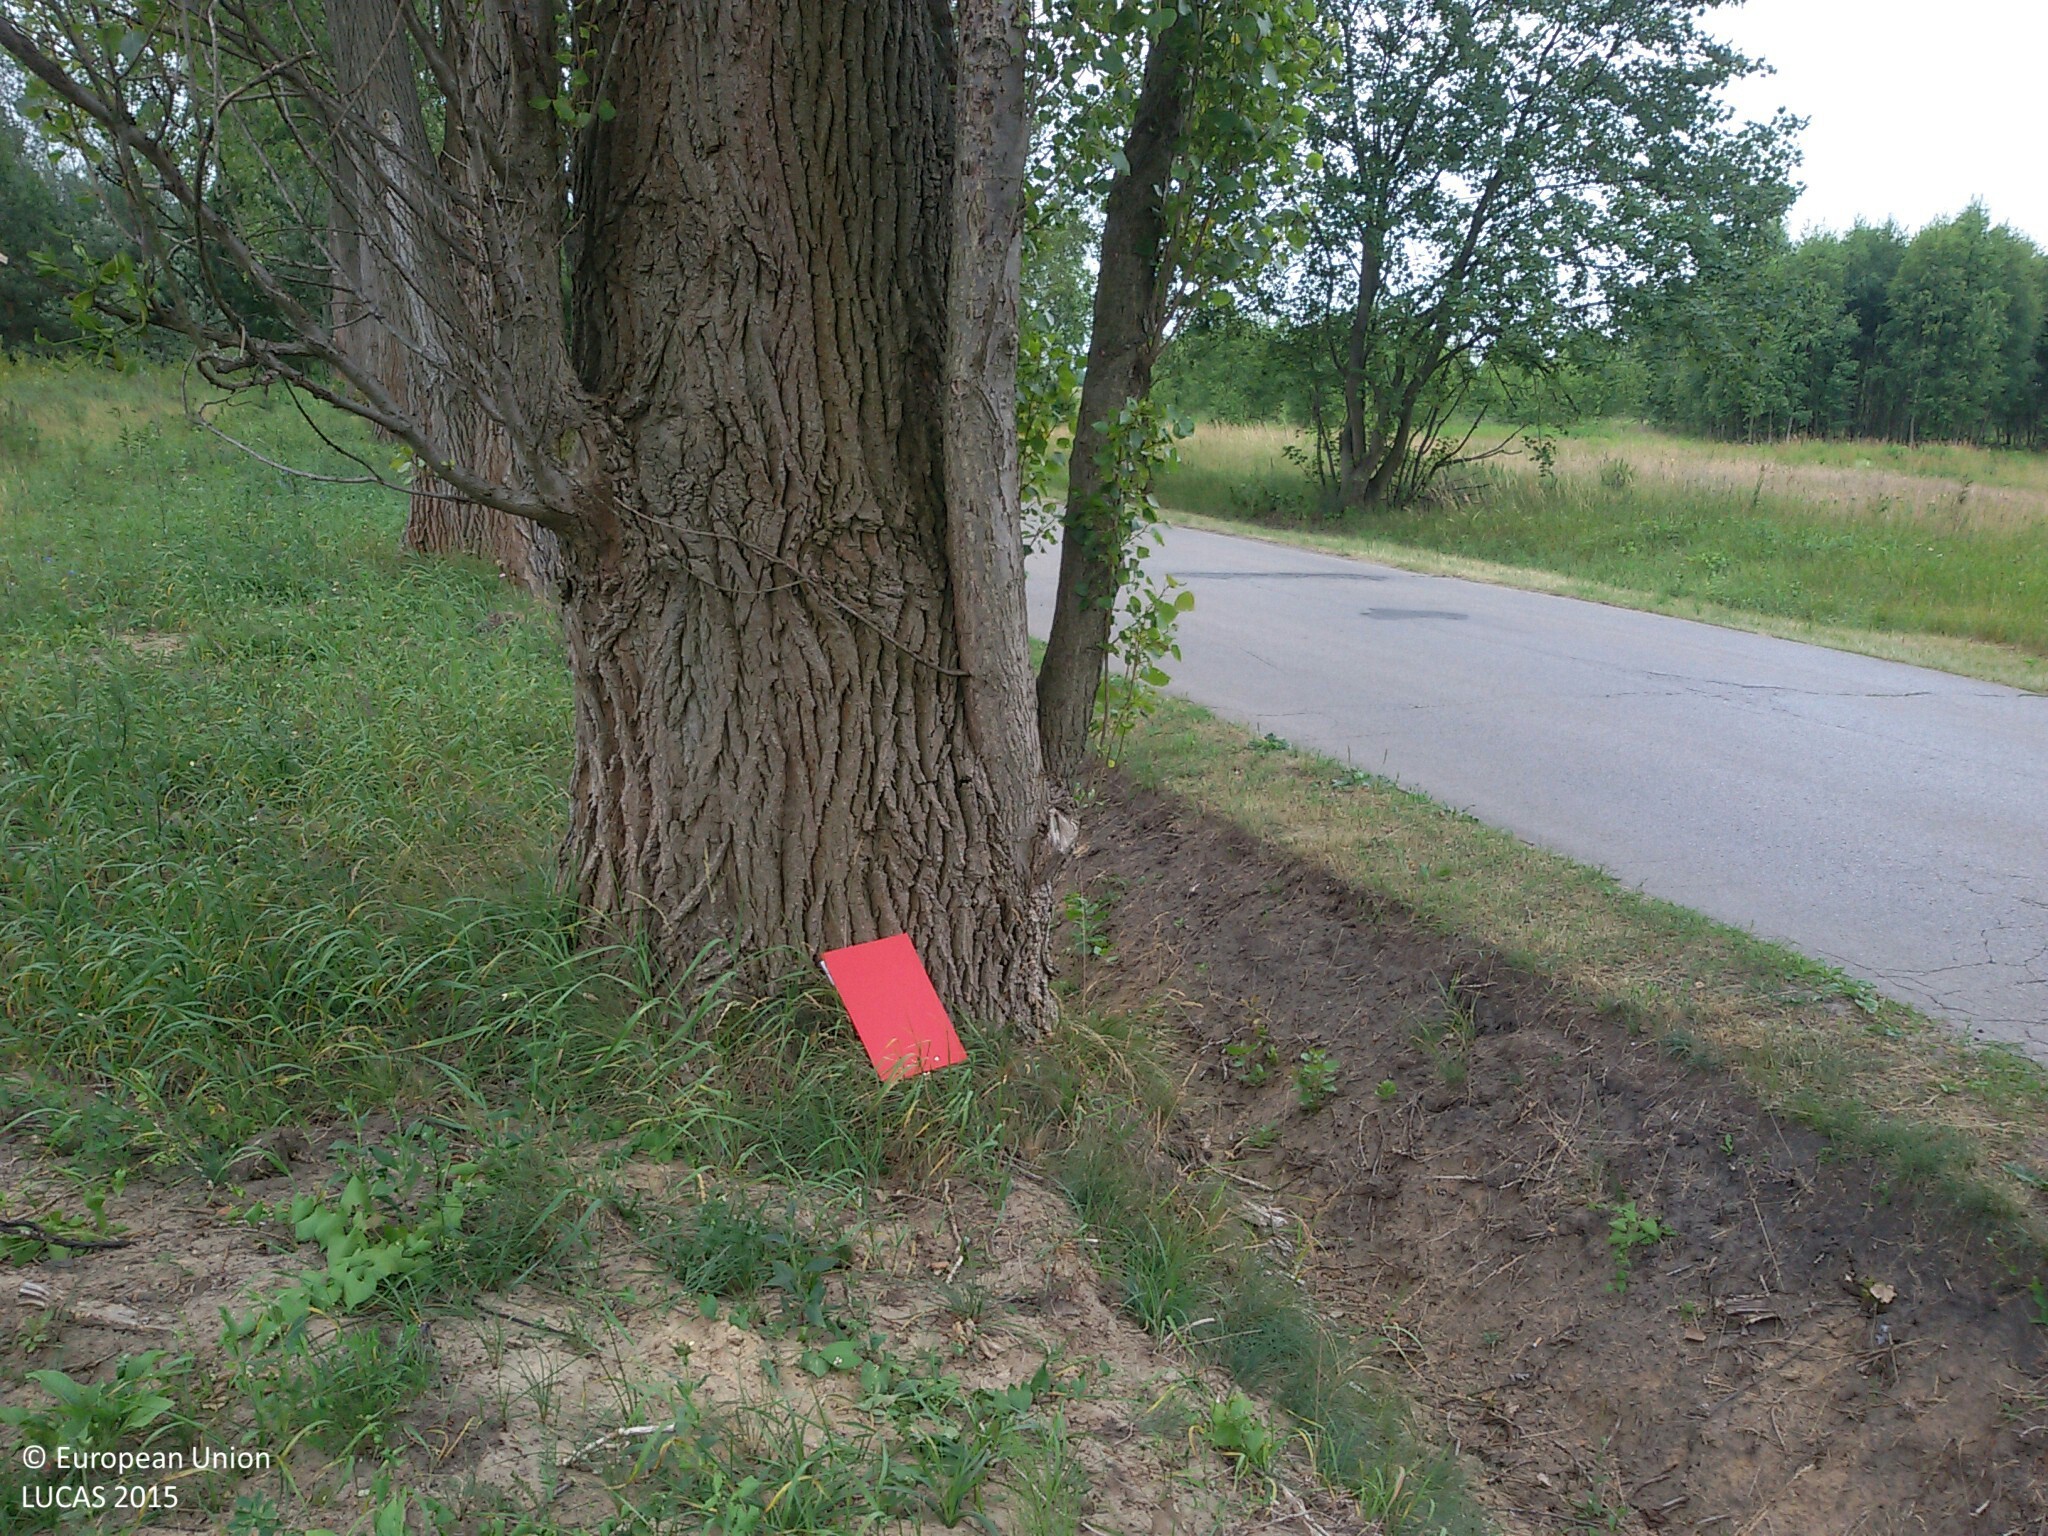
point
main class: Grassland
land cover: Grassland with sparse tree/shrub cover
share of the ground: > 75 %
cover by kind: herbaceous plants 95 %, broadleaved forest trees 5 %
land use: Road transport
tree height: > 5 m
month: June
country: PL
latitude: 52.2632
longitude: 20.8112
